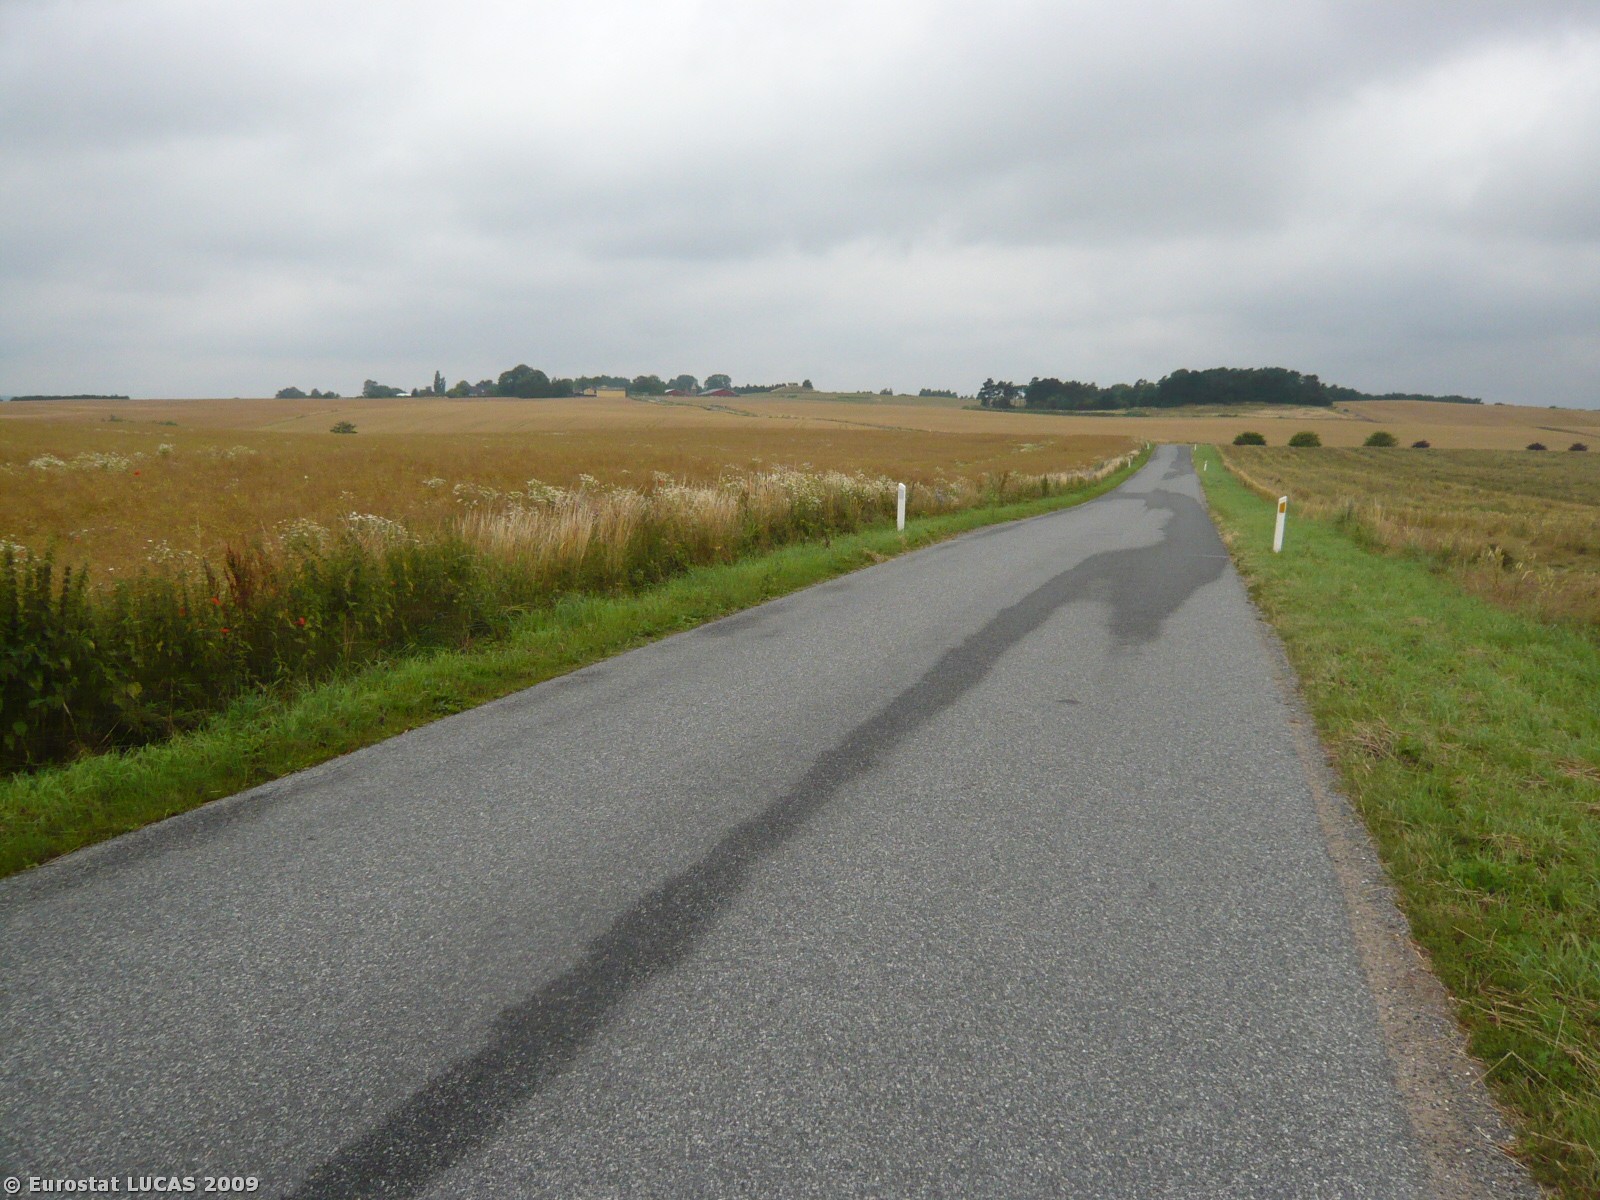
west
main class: Cropland
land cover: Rape and turnip rape
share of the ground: > 75 %
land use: Agriculture (excluding fallow land and kitchen gardens)
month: July
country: DK
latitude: 55.7423
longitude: 11.8938
